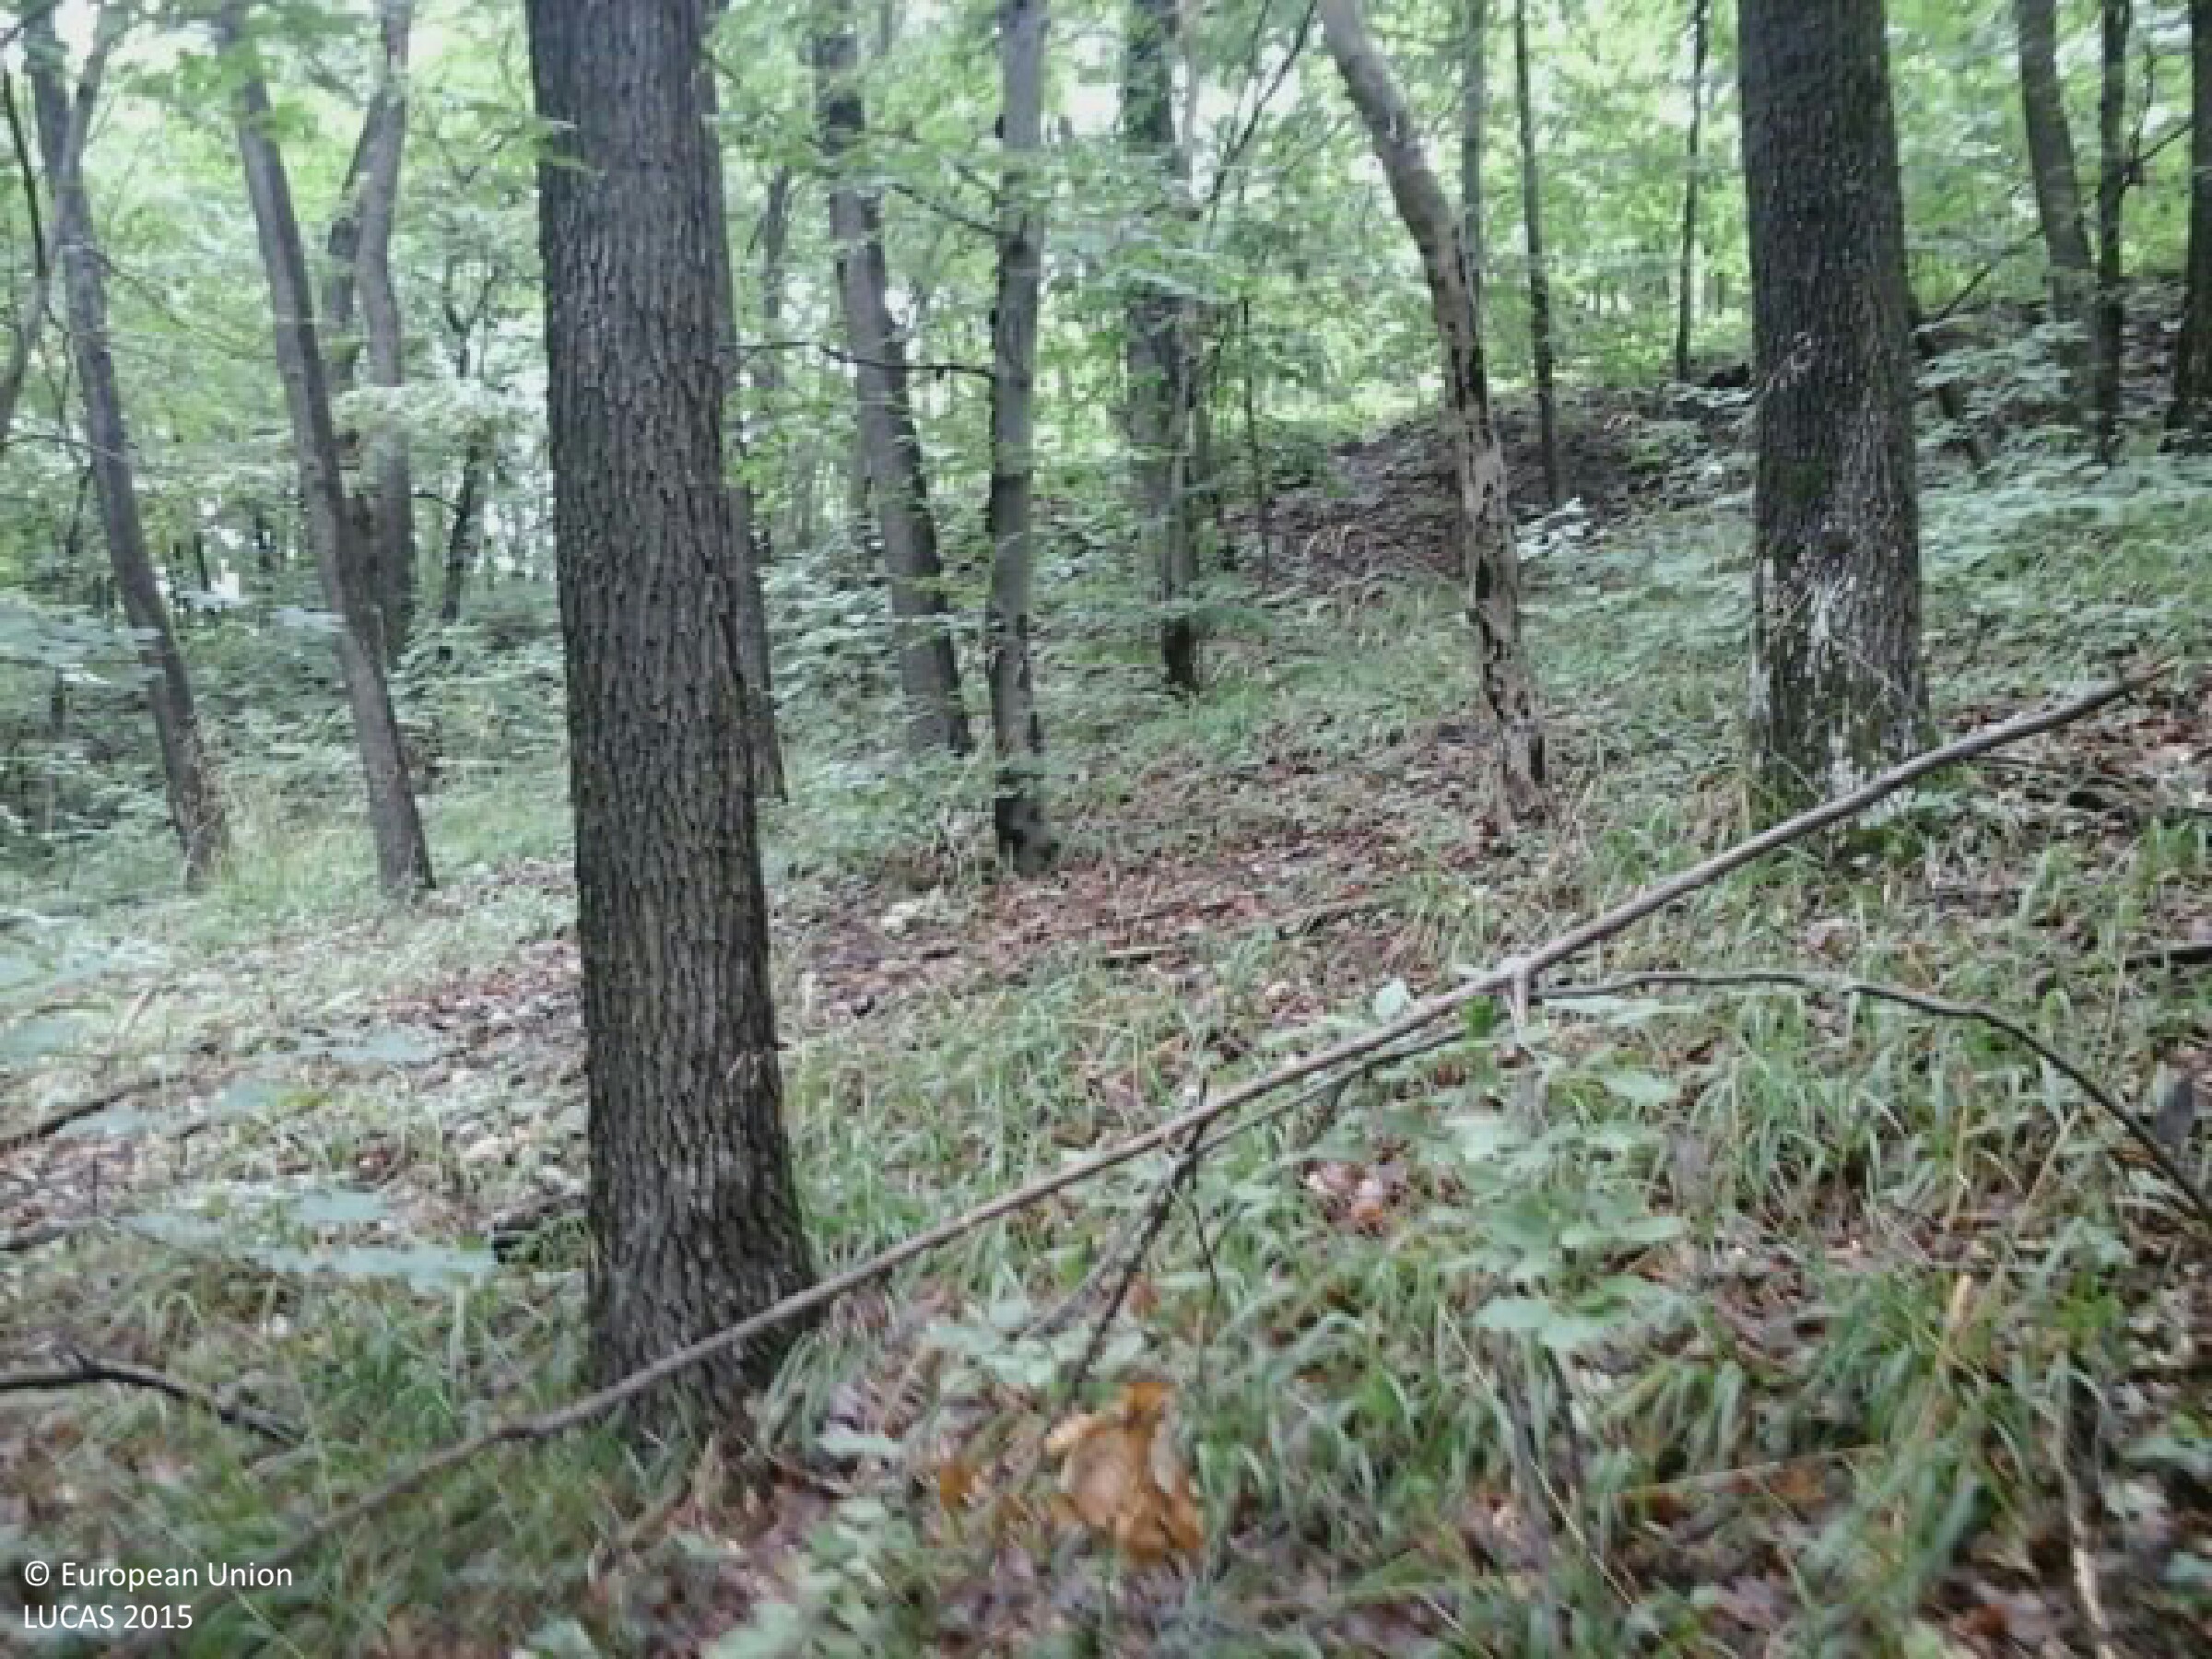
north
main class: Woodland
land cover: Broadleaved woodland
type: beech forest
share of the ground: > 75 %
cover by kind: broadleaved forest trees 90 %, herbaceous plants 10 %
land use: Forestry
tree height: > 5 m
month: July
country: HU
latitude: 46.1799
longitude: 17.9732
